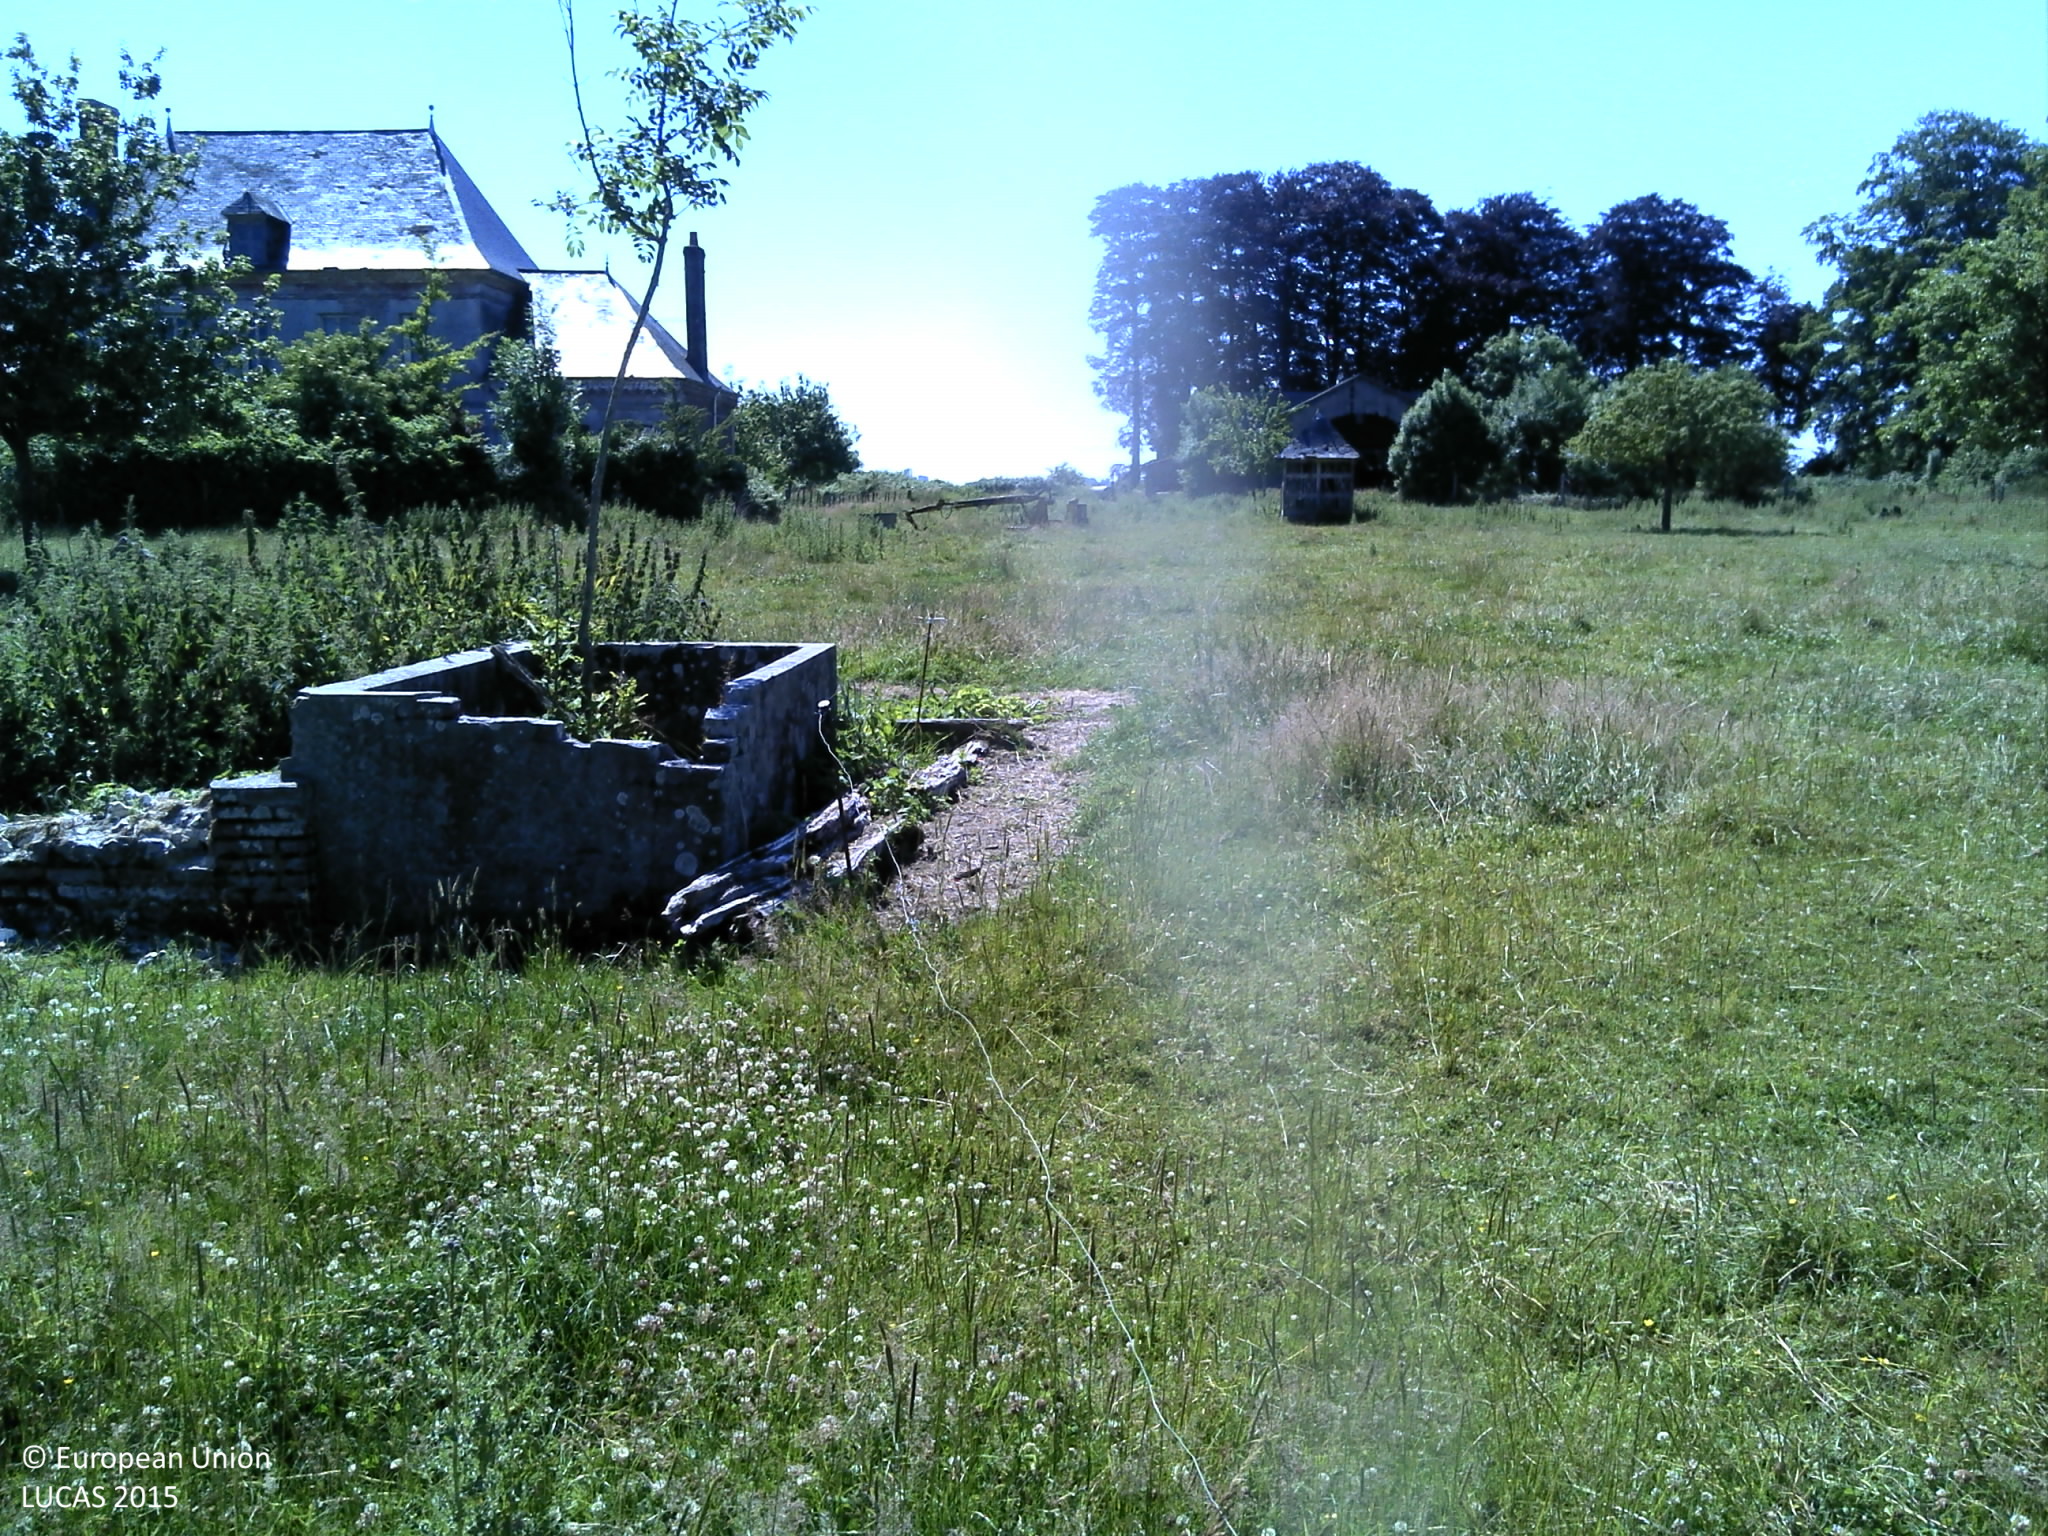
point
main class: Grassland
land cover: Grassland with sparse tree/shrub cover
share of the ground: > 75 %
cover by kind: herbaceous plants 95 %, broadleaved forest trees 5 %
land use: Agriculture (excluding fallow land and kitchen gardens)
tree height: < 5 m
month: June
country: FR
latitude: 49.8308
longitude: 1.0385
